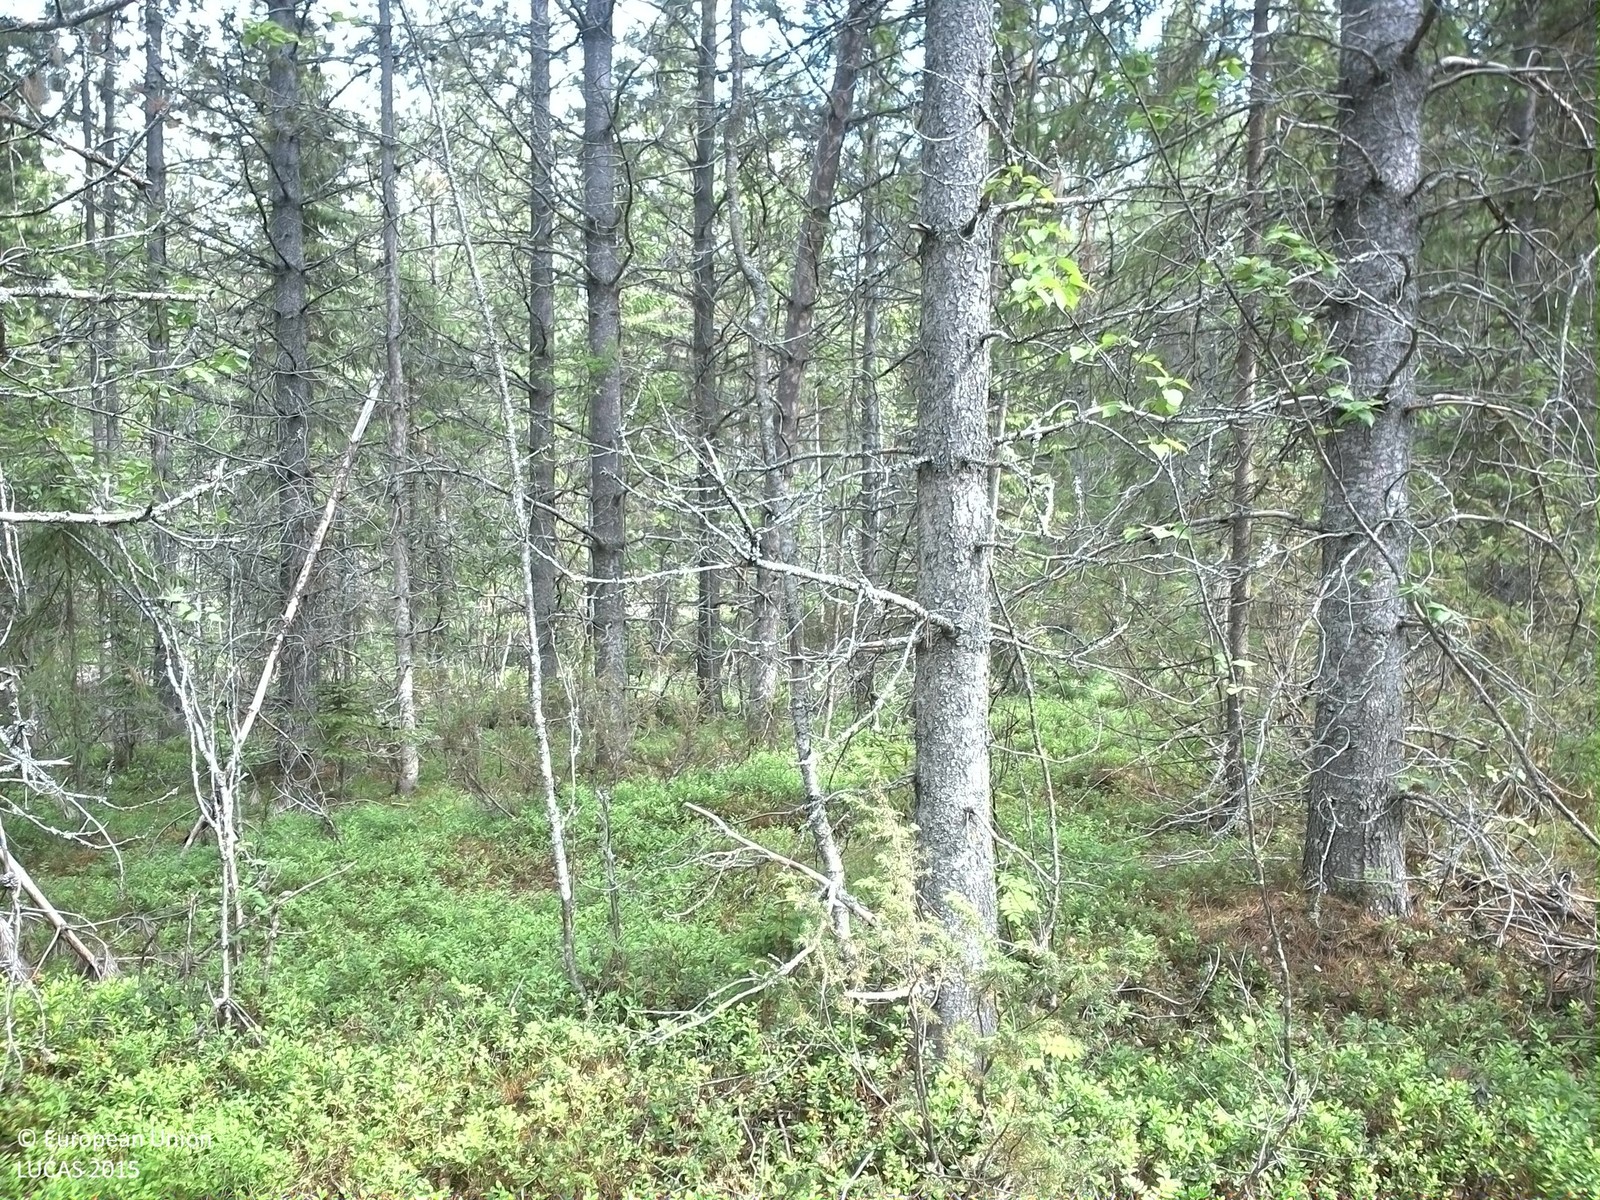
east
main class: Woodland
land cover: Pine dominated coniferous woodland
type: exotic forest
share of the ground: > 75 %
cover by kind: coniferous forest trees 70 %, shrubs 20 %, broadleaved forest trees 10 %
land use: Forestry
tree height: > 5 m
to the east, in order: Pine dominated coniferous woodland; Pine dominated mixed woodland; Spruce dominated coniferous woodland
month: July
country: SE
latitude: 63.5203
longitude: 17.3512
